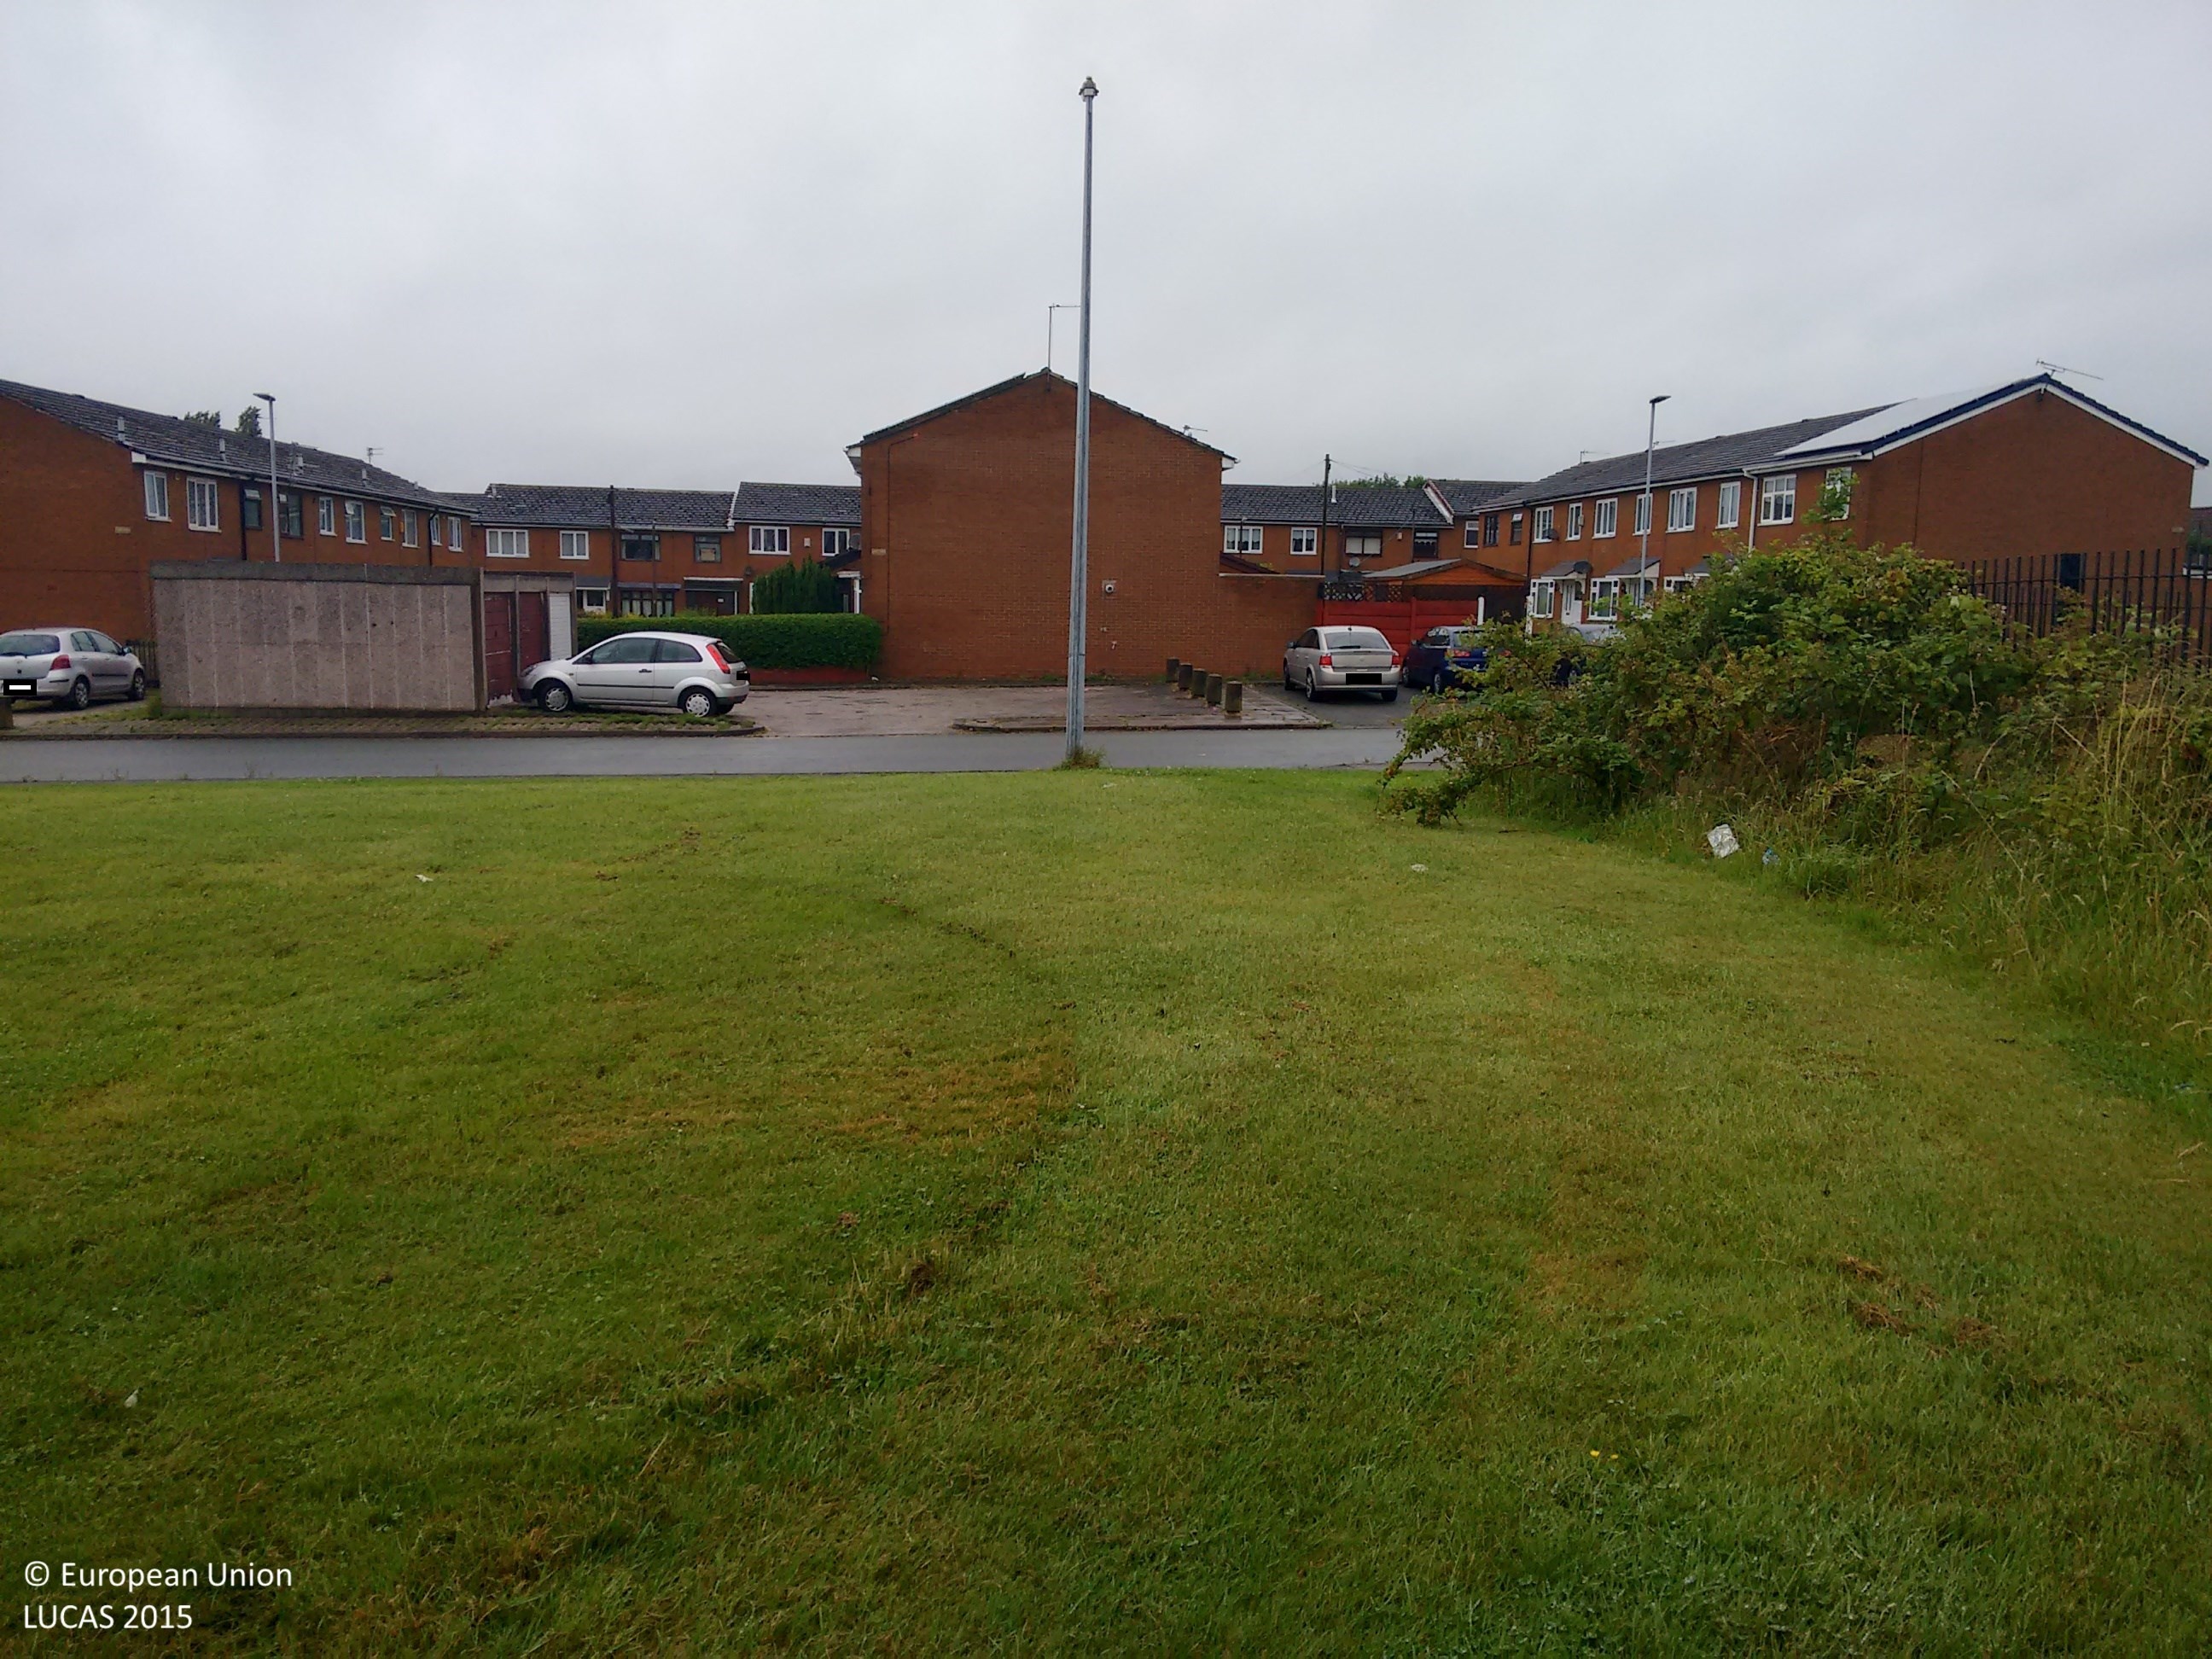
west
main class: Grassland
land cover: Grassland with sparse tree/shrub cover
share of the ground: > 75 %
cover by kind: herbaceous plants 95 %, broadleaved forest trees 5 %
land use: Amenities, museums, leisure
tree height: > 5 m
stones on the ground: < 10 %
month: July
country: GB
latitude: 53.3777
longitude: -2.7725
